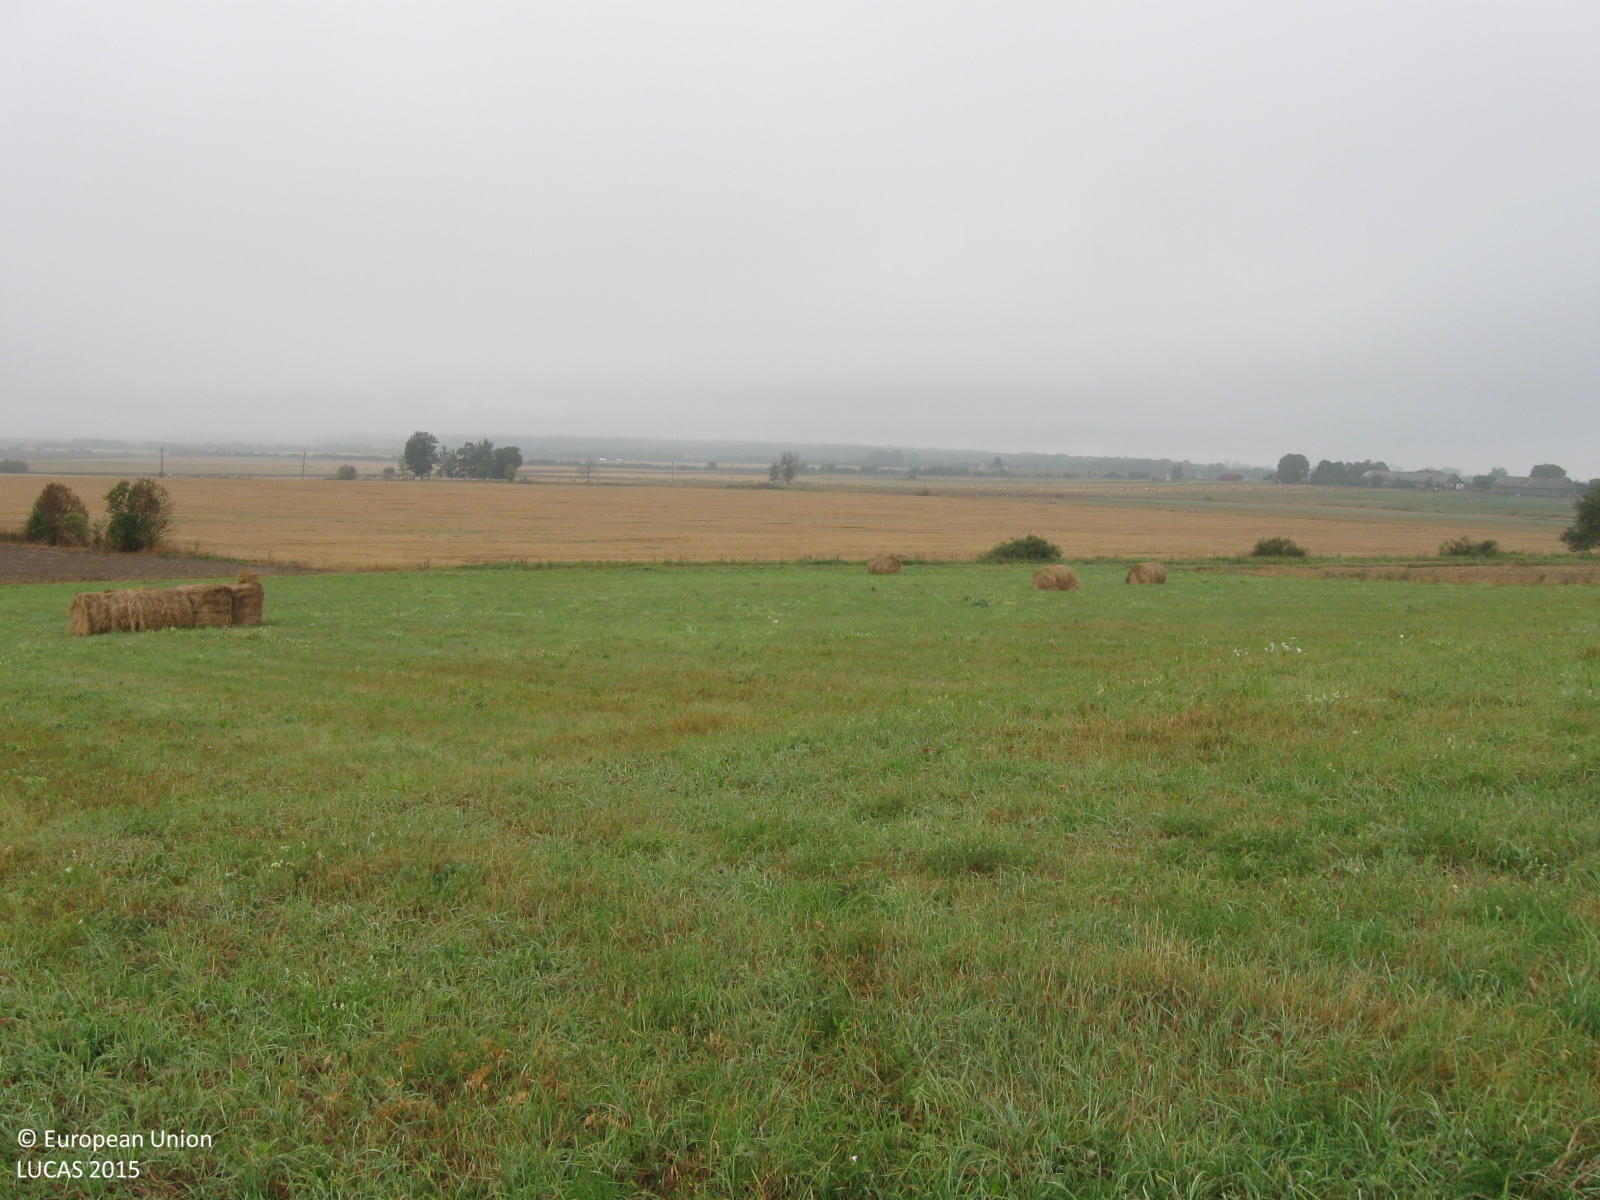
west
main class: Grassland
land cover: Grassland without tree/shrub cover
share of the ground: > 75 %
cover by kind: herbaceous plants 100 %
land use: Agriculture (excluding fallow land and kitchen gardens)
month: August
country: LT
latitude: 55.3402
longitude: 23.1757
